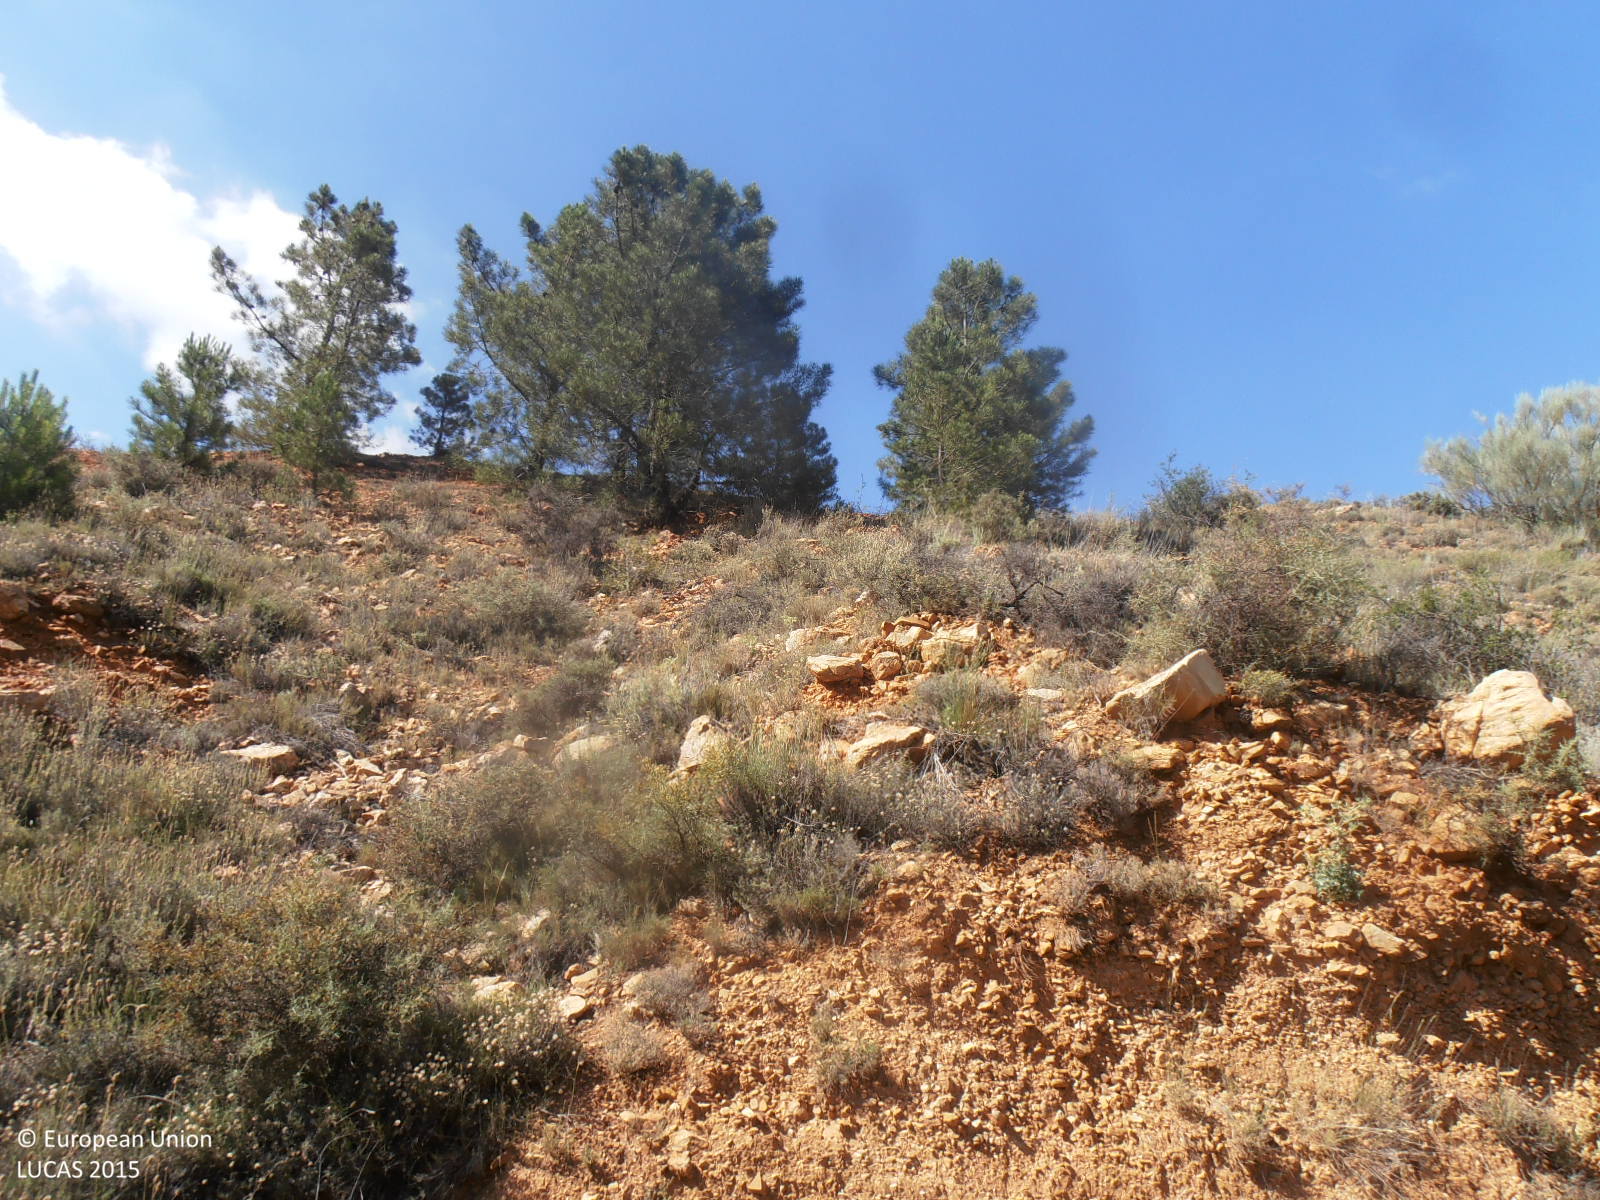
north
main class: Shrubland
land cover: Shrubland without tree cover
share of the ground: > 75 %
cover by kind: shrubs 100 %
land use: Abandoned areas
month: June
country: ES
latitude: 41.3326
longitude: -1.4102
